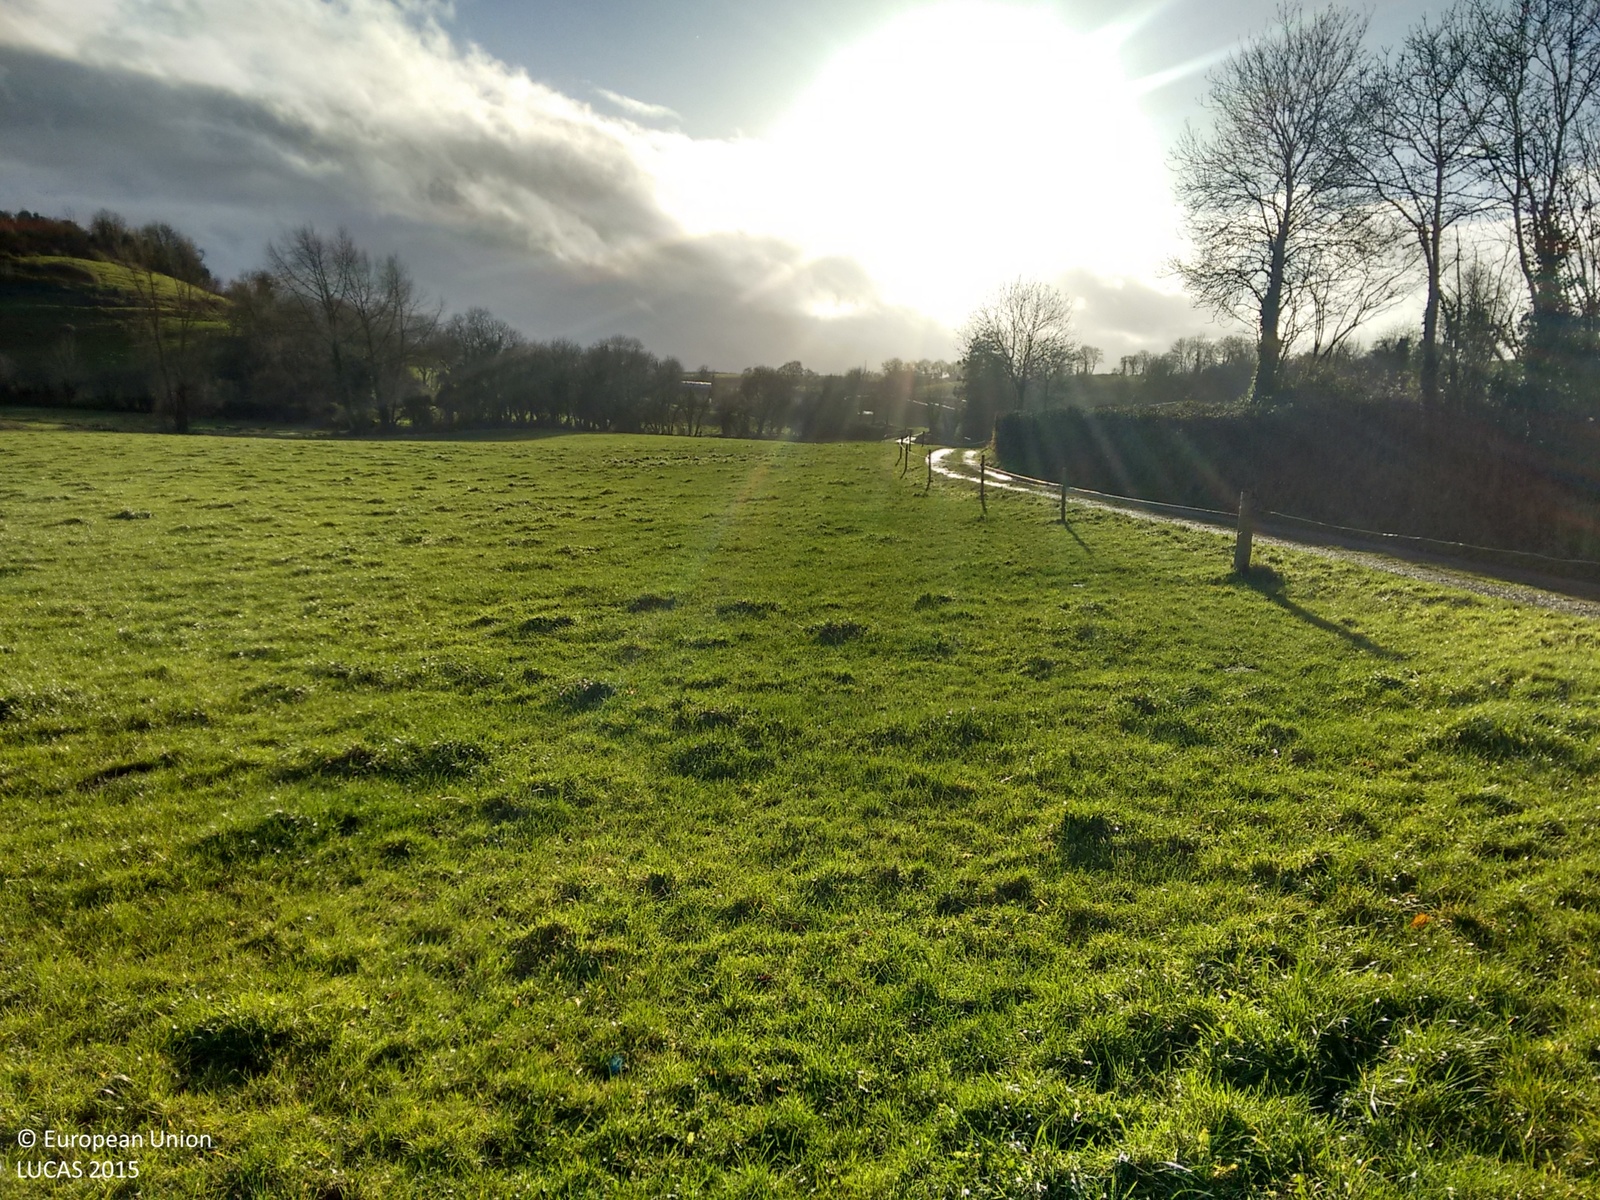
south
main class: Grassland
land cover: Grassland without tree/shrub cover
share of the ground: > 75 %
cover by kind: herbaceous plants 100 %
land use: Agriculture (excluding fallow land and kitchen gardens)
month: December
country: IE
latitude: 53.9068
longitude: -6.6770
